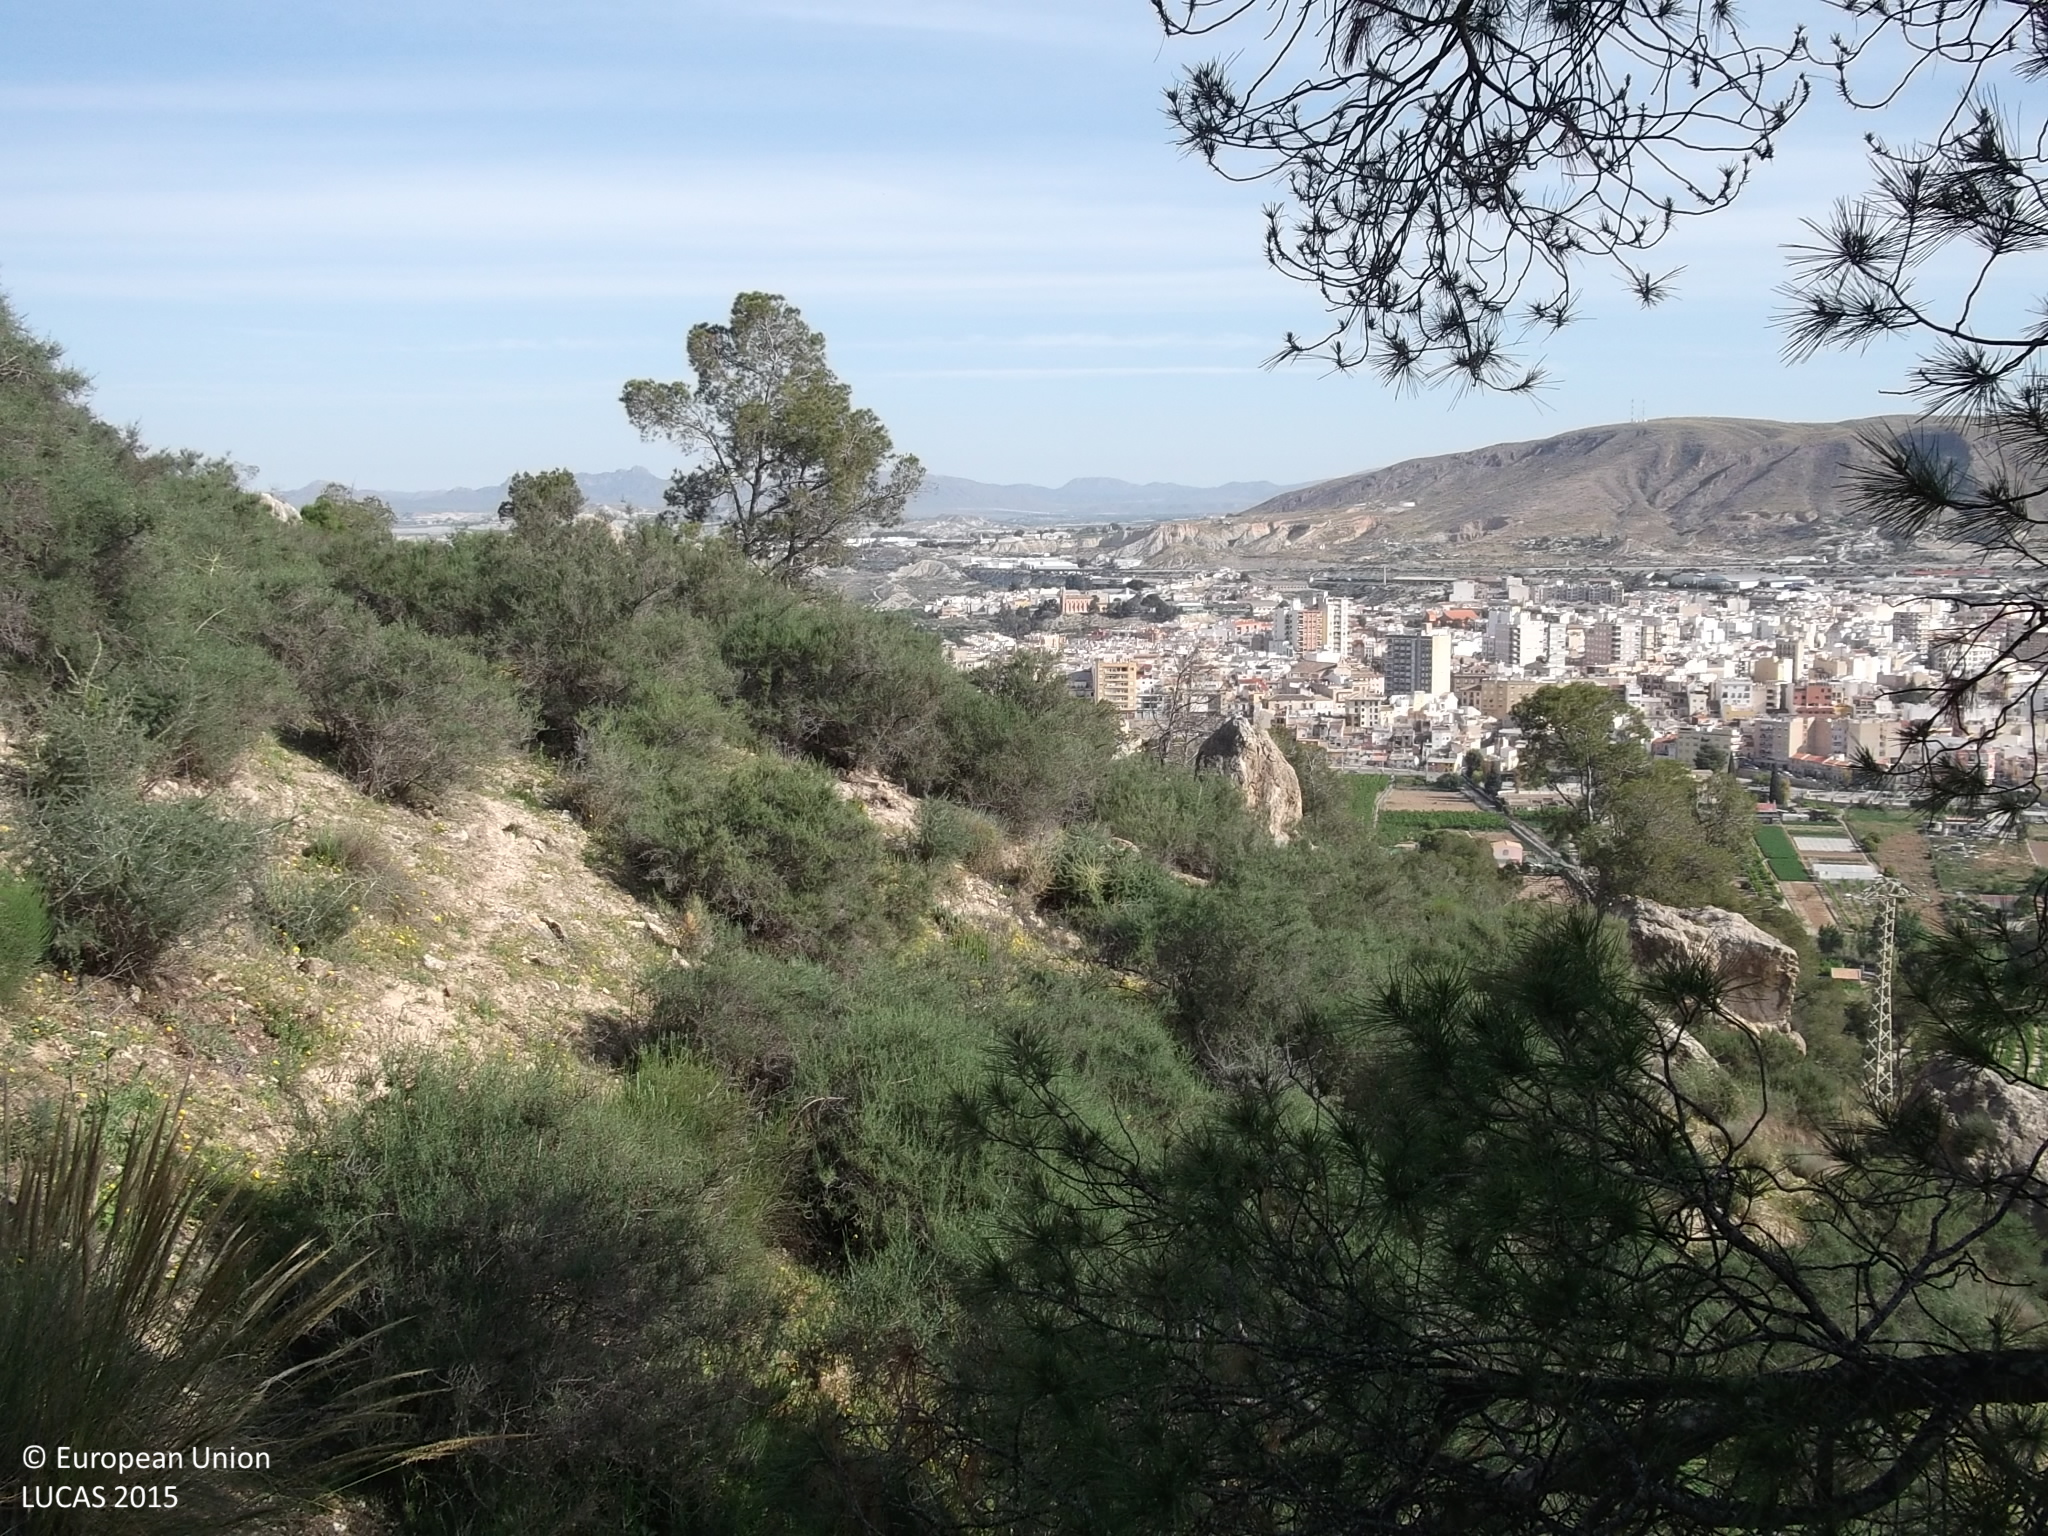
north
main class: Woodland
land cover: Pine dominated coniferous woodland
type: coniferous forest of the mediterranean region
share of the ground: 10 - 25 %
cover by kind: shrubs 65 %, herbaceous plants 20 %, coniferous forest trees 15 %
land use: Semi-natural and natural areas not in use
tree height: > 5 m
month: April
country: ES
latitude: 38.2276
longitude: -1.4231
